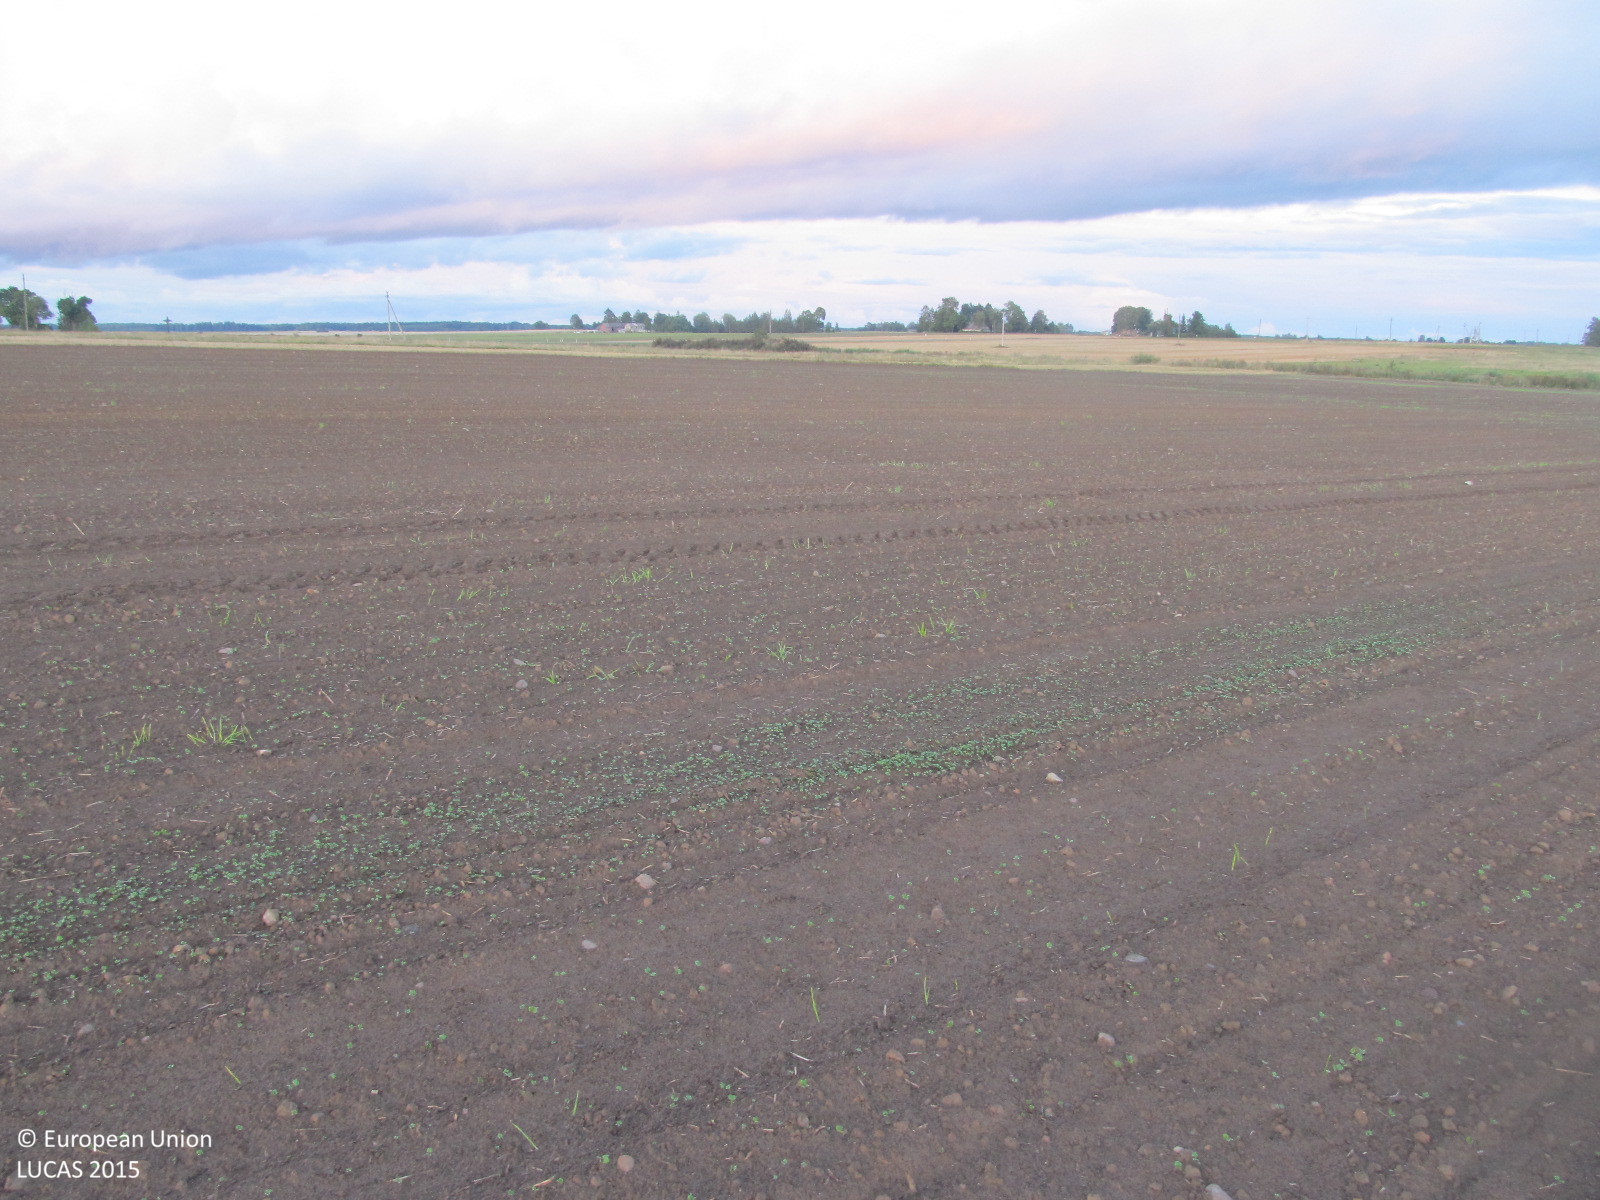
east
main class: Cropland
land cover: Rape and turnip rape
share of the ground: < 10 %
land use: Agriculture (excluding fallow land and kitchen gardens)
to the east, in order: Rape and turnip rape; Barley; Grassland without tree/shrub cover; Spontaneously vegetated surfaces; Ditches and canals; Spontaneously vegetated surfaces; Other bare soil
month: September
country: LT
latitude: 56.1628
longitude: 23.1615
